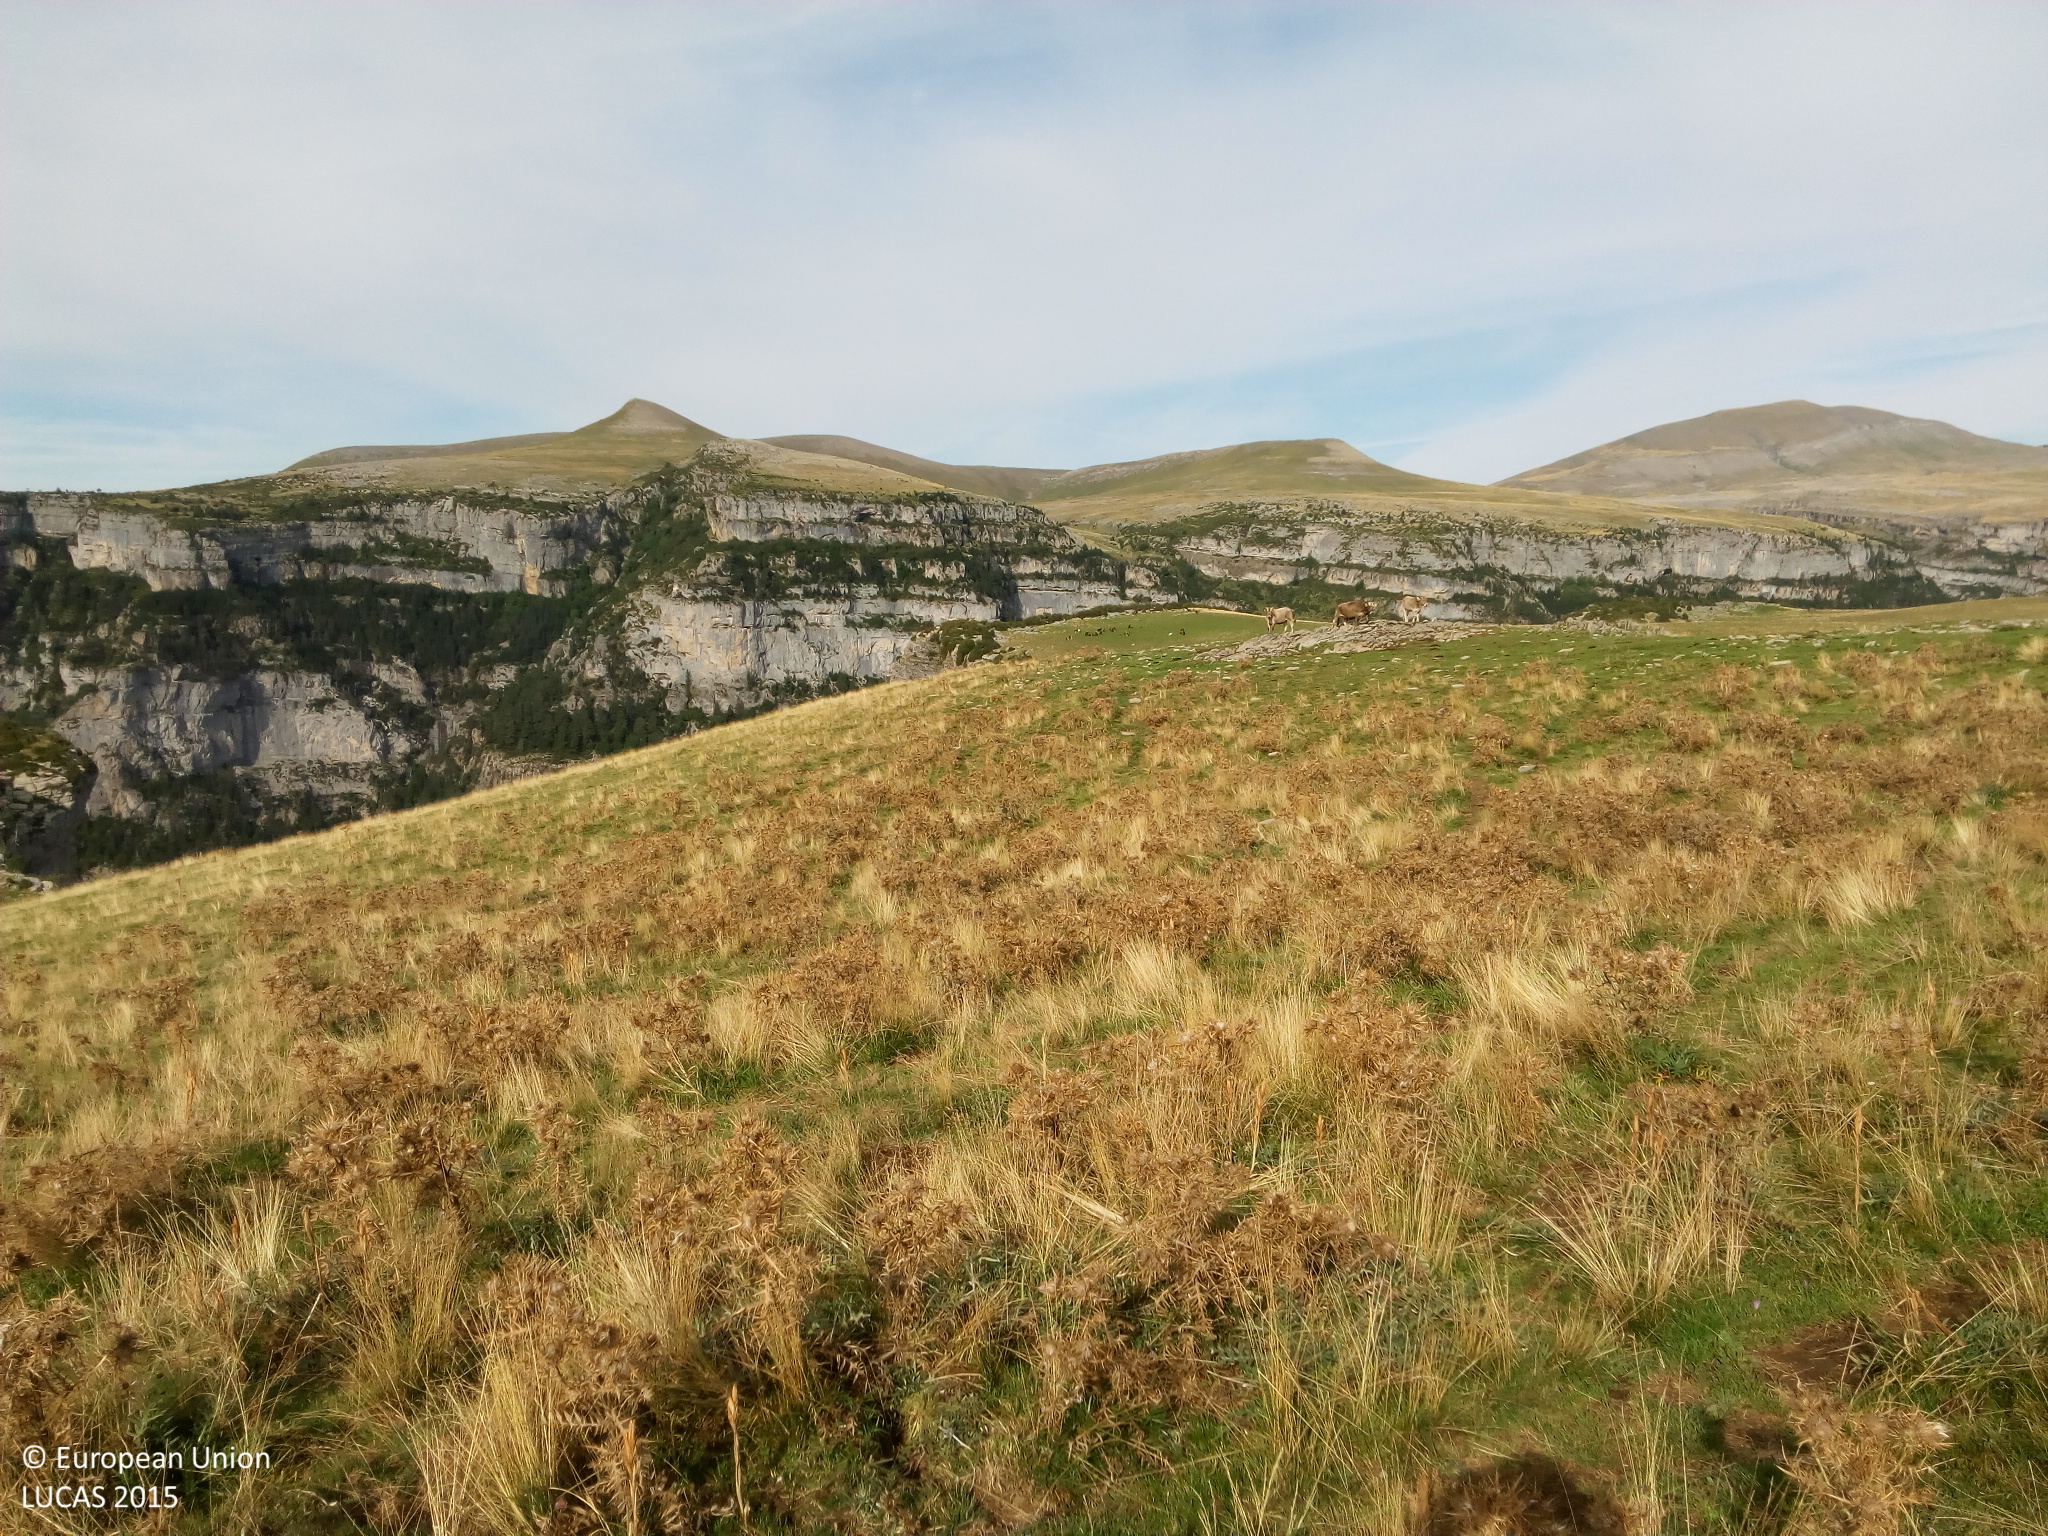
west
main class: Grassland
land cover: Grassland without tree/shrub cover
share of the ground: > 75 %
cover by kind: herbaceous plants 100 %
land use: Semi-natural and natural areas not in use
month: September
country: ES
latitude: 42.6011
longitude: 0.0680
